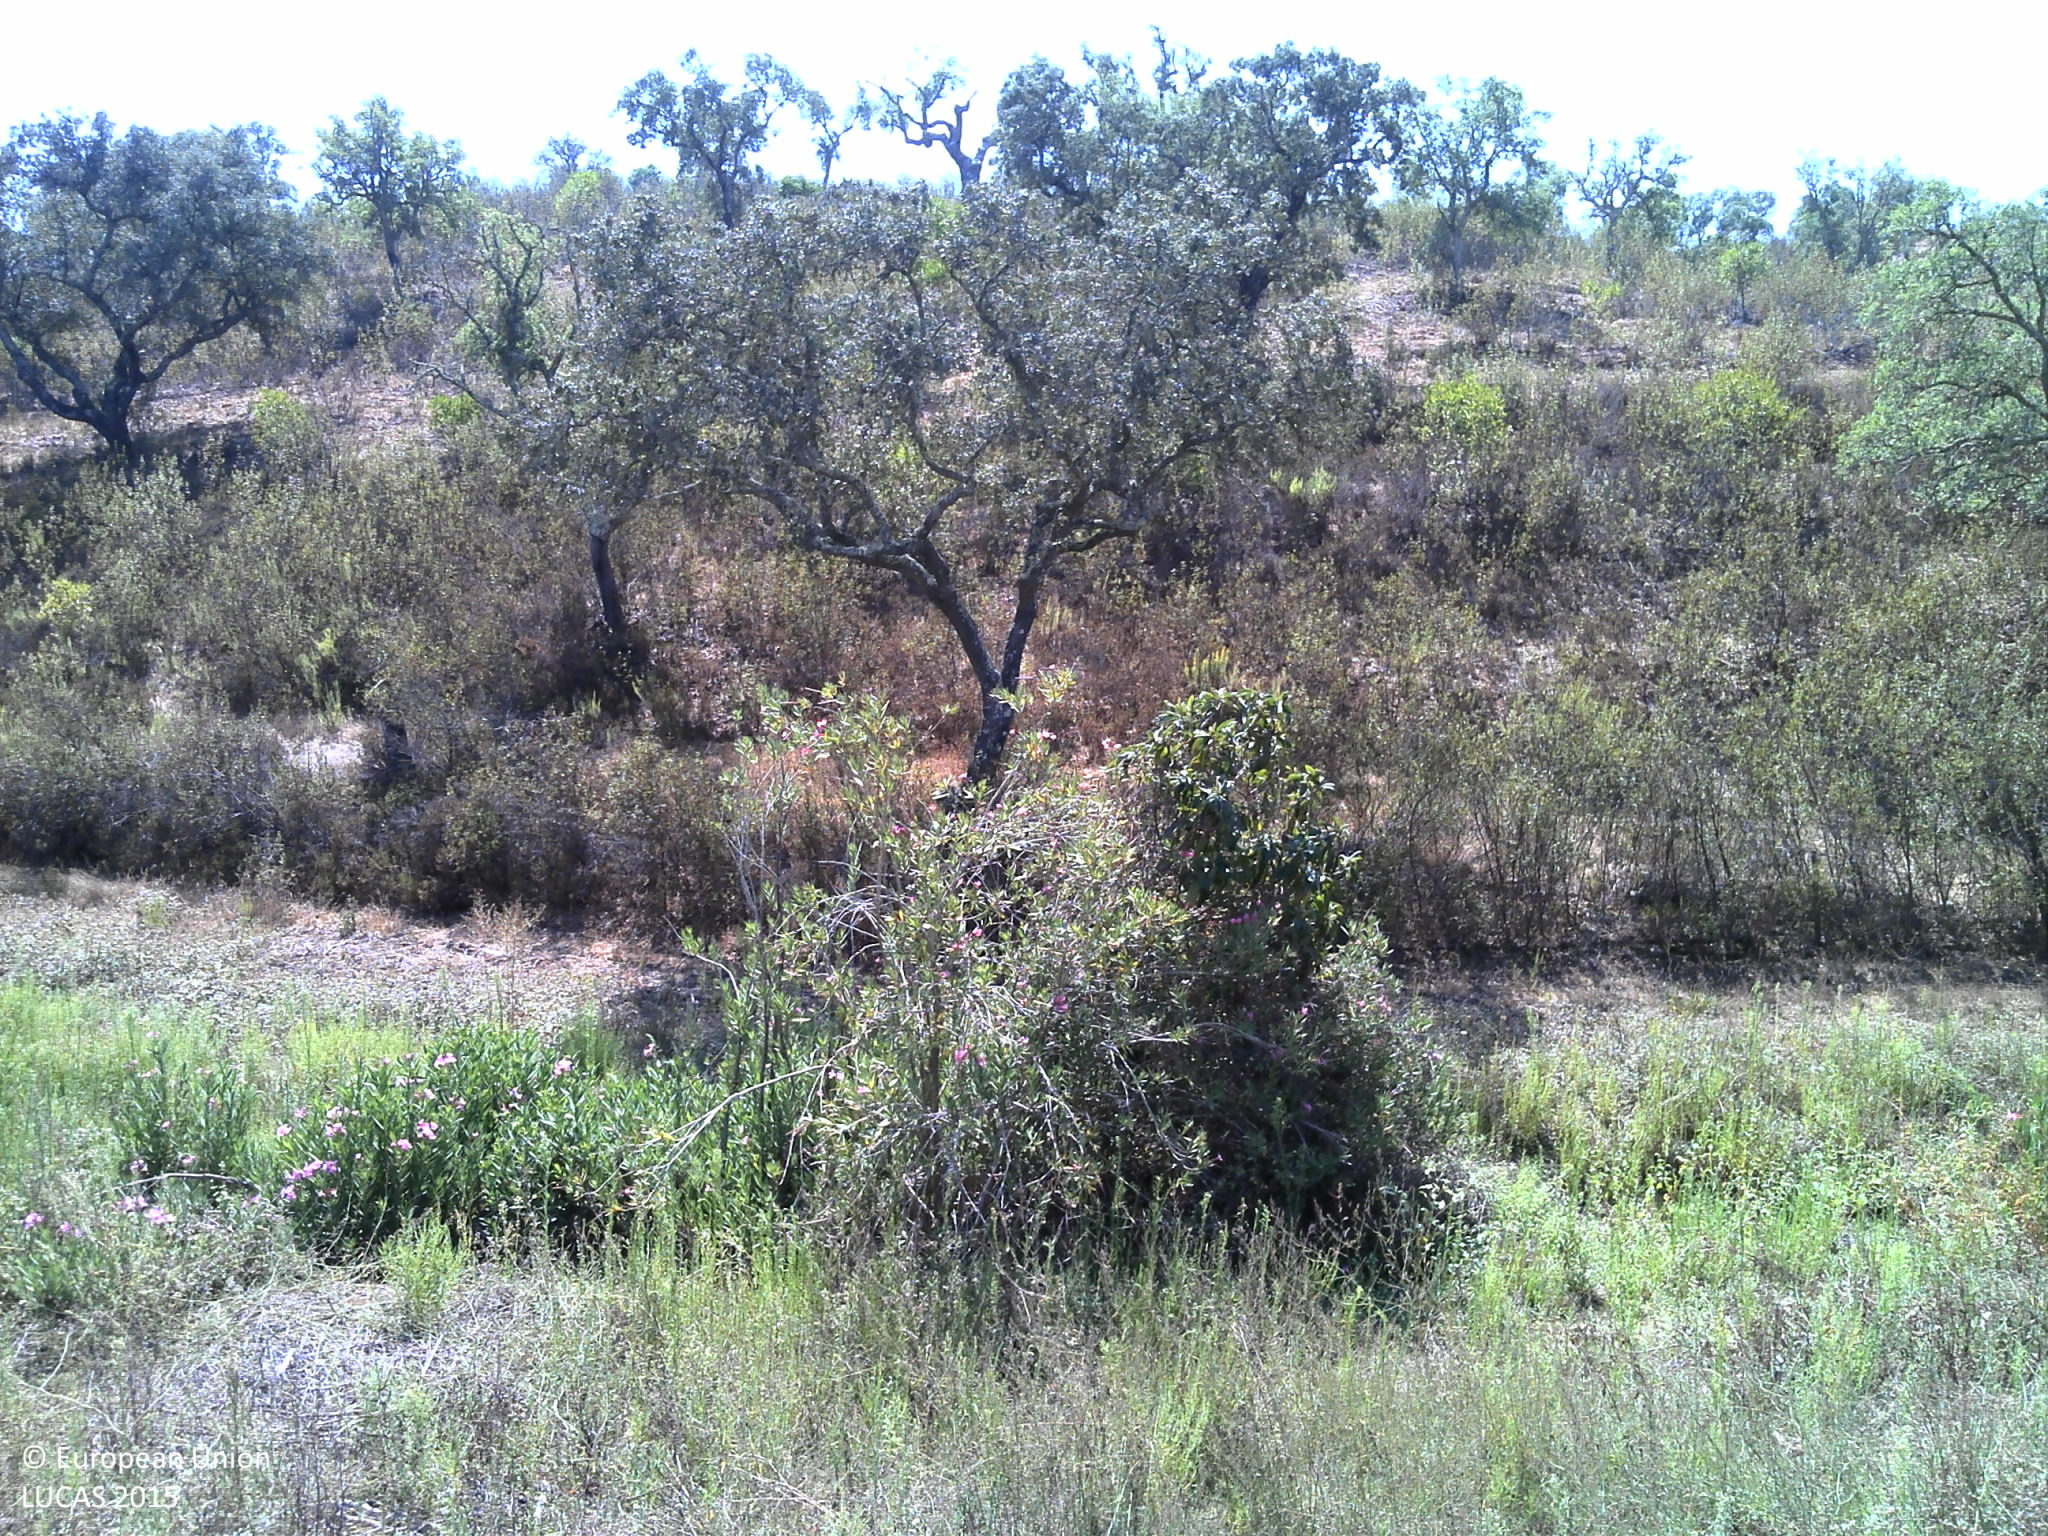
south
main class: Shrubland
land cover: Shrubland with sparse tree cover
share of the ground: 25 - 50 %
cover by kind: shrubs 40 %, herbaceous plants 40 %, unconsolidated bare surface 15 %, broadleaved forest trees 5 %
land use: Forestry
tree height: < 5 m
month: September
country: PT
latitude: 37.4985
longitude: -8.2719
